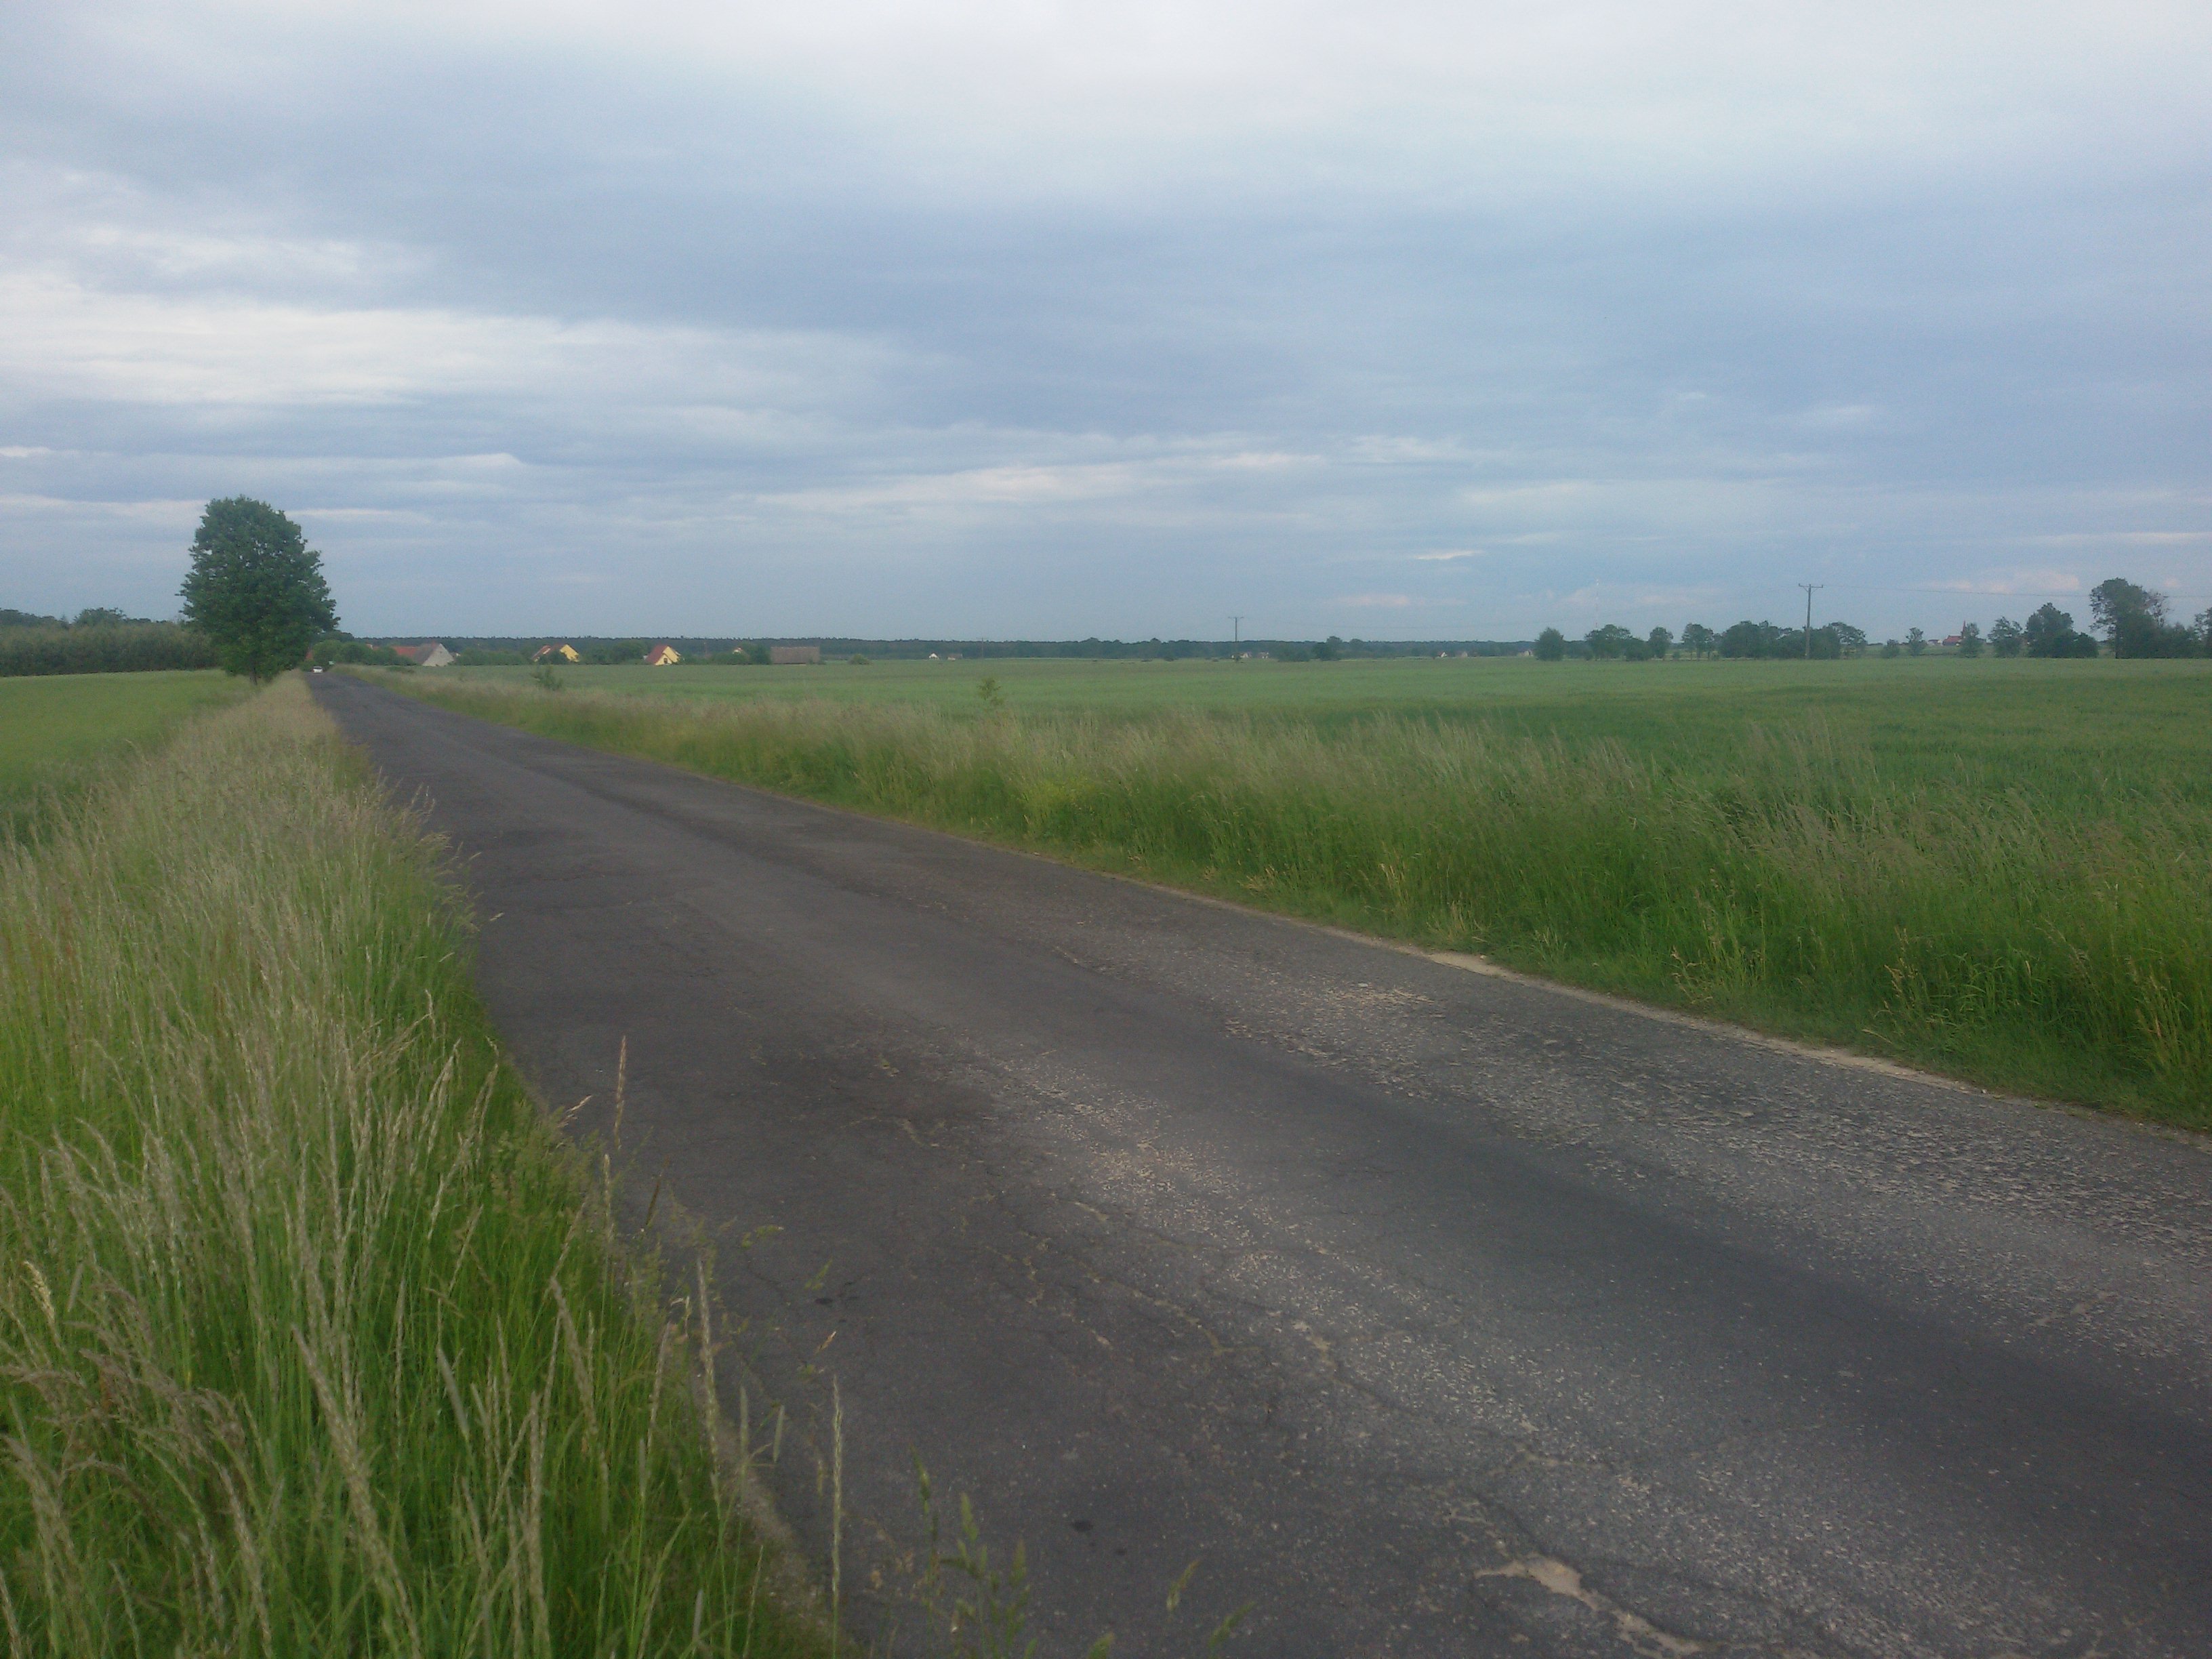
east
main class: Cropland
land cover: Rape and turnip rape
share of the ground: > 75 %
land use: Agriculture (excluding fallow land and kitchen gardens)
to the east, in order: Grass margins; Paved roads, cycling and walking lanes; Grass margins; Common wheat
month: June
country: PL
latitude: 50.5056
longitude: 17.6416
